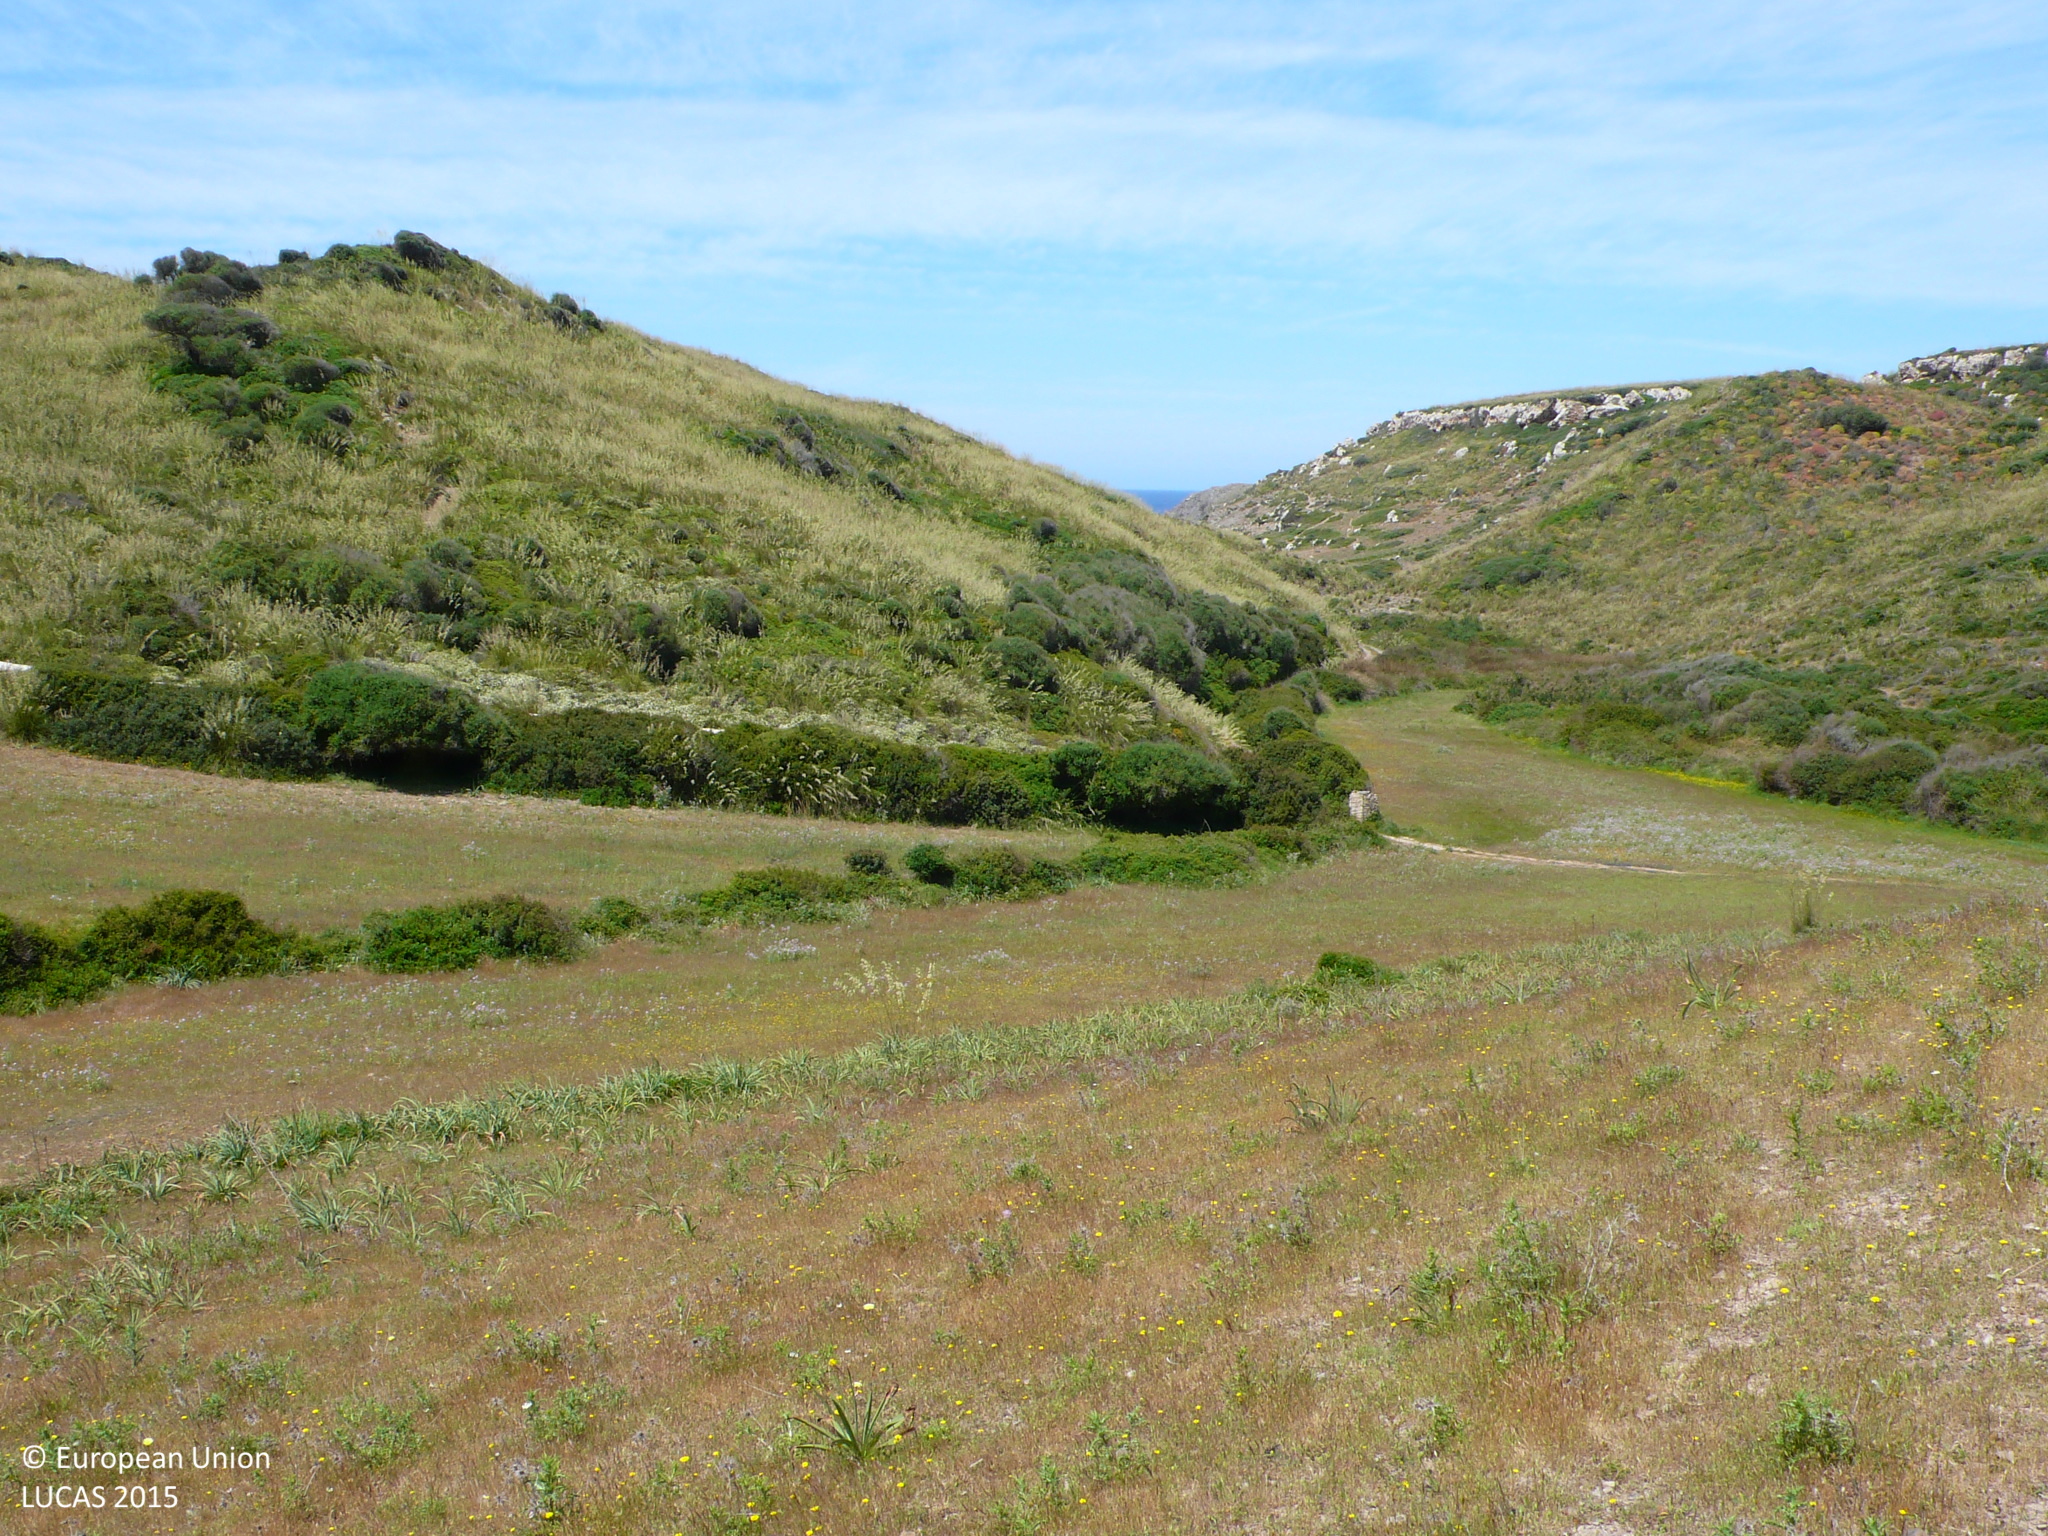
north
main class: Grassland
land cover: Grassland without tree/shrub cover
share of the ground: > 75 %
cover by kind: herbaceous plants 95 %, shrubs 5 %
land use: Agriculture (excluding fallow land and kitchen gardens)
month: May
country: ES
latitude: 39.9885
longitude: 4.2285
